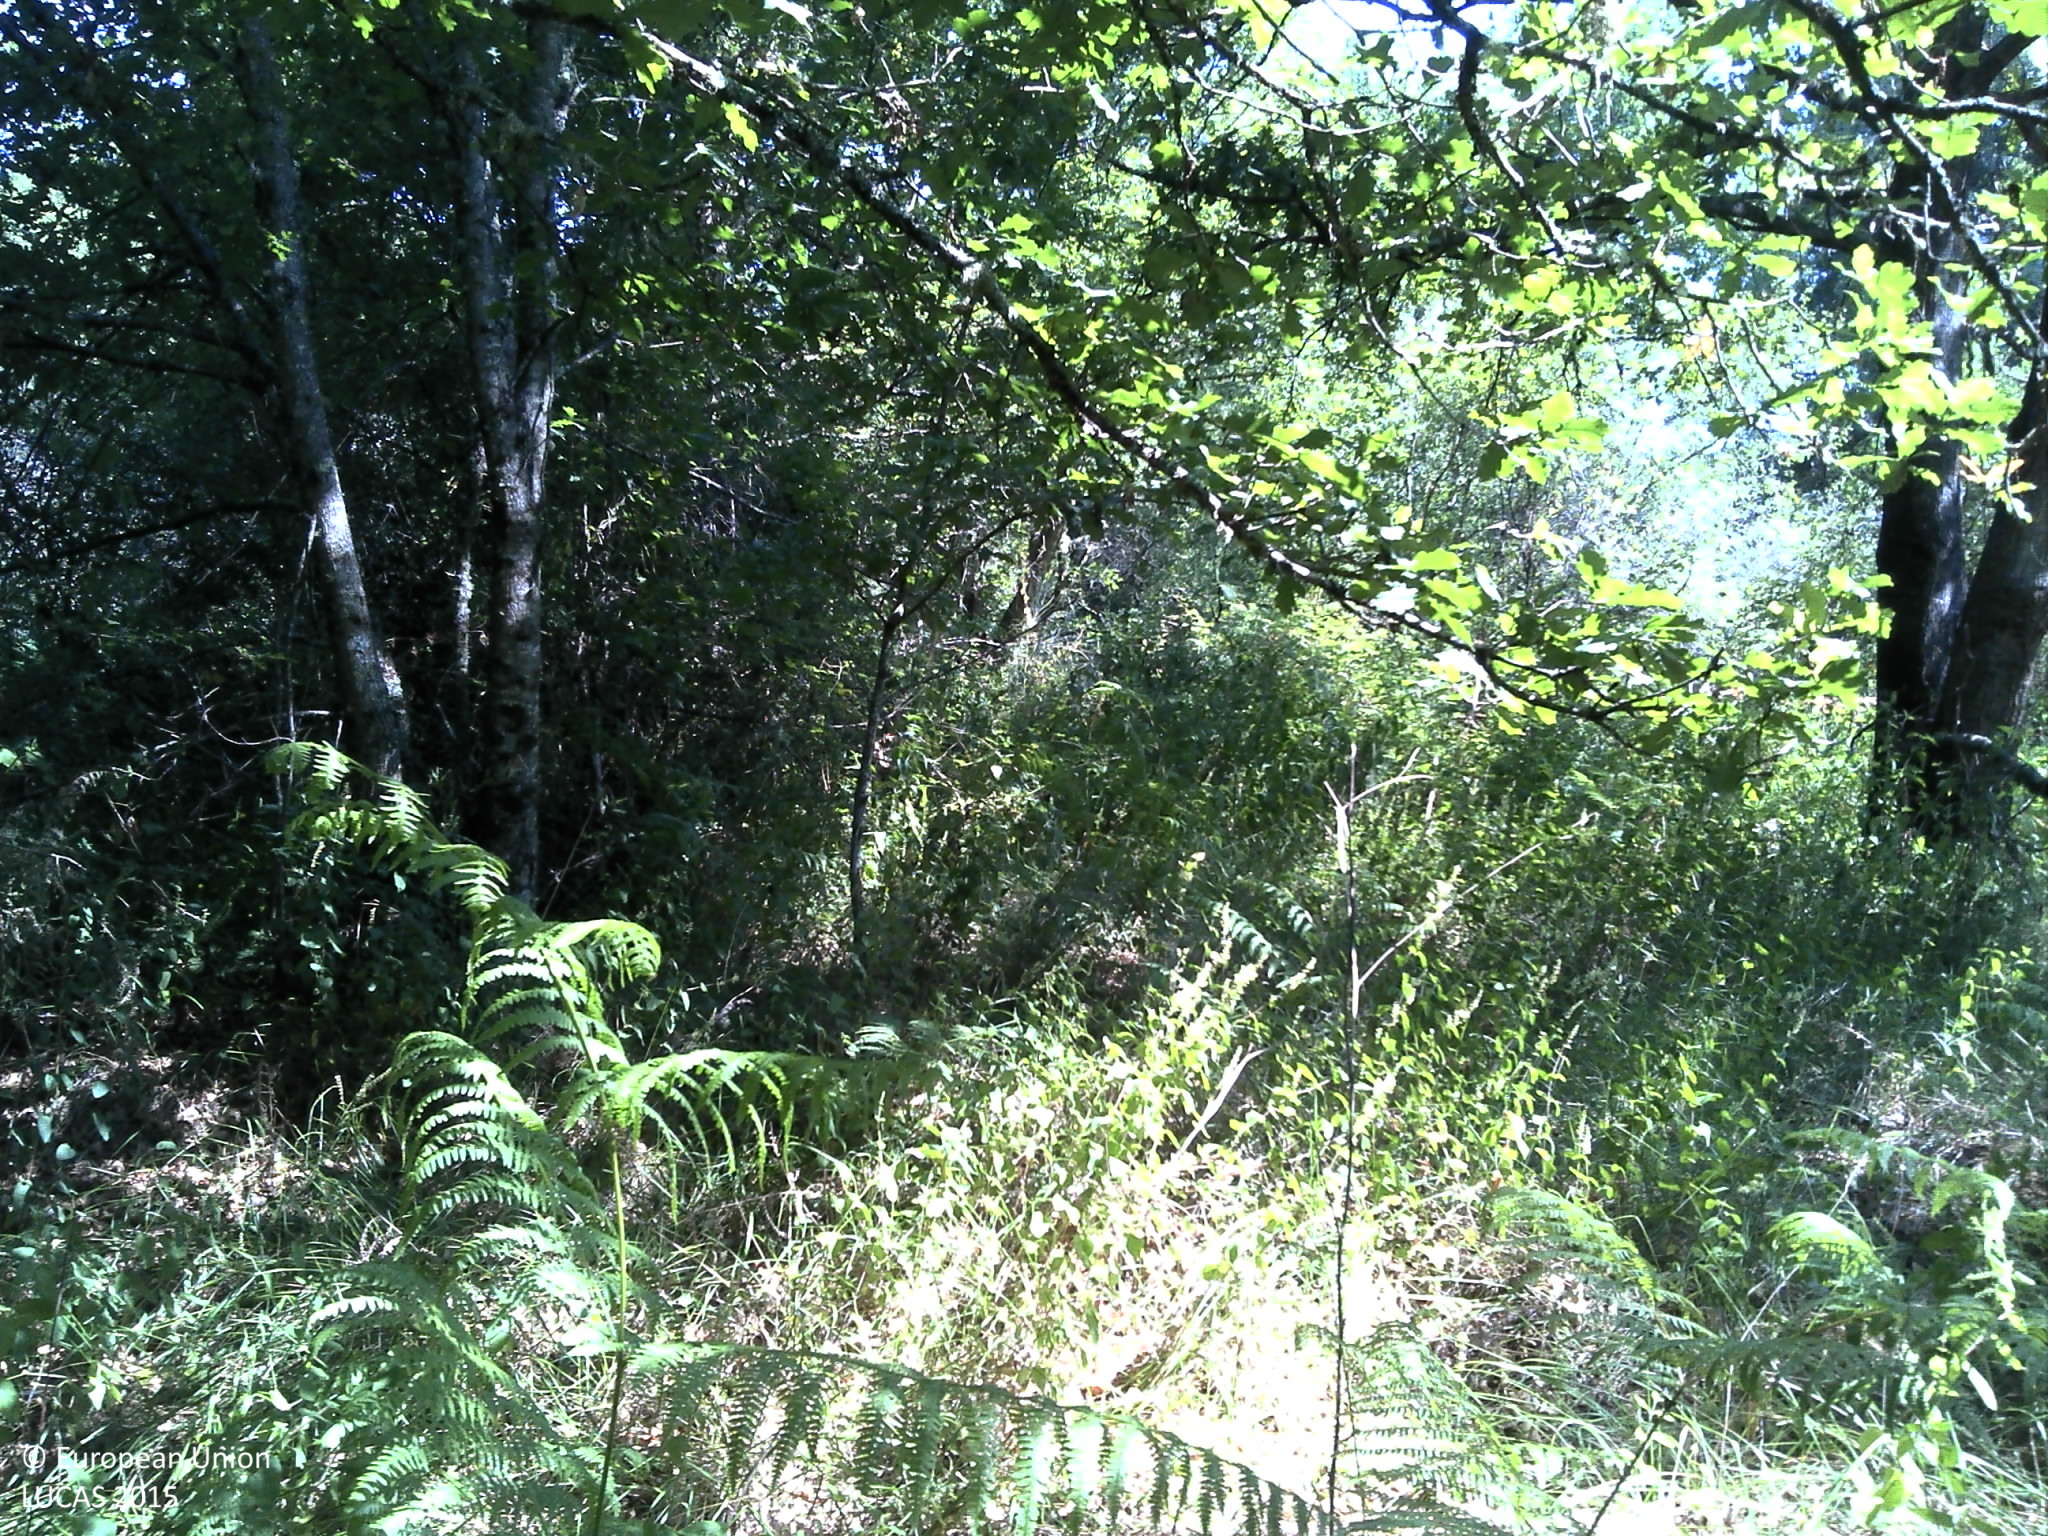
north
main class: Woodland
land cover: Broadleaved woodland
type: thermophilous deciduous forest
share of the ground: 10 - 25 %
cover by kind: shrubs 40 %, broadleaved forest trees 20 %, herbaceous plants 20 %, unconsolidated bare surface 20 %
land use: Forestry
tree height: > 5 m
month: July
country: PT
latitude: 40.7566
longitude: -7.8566
